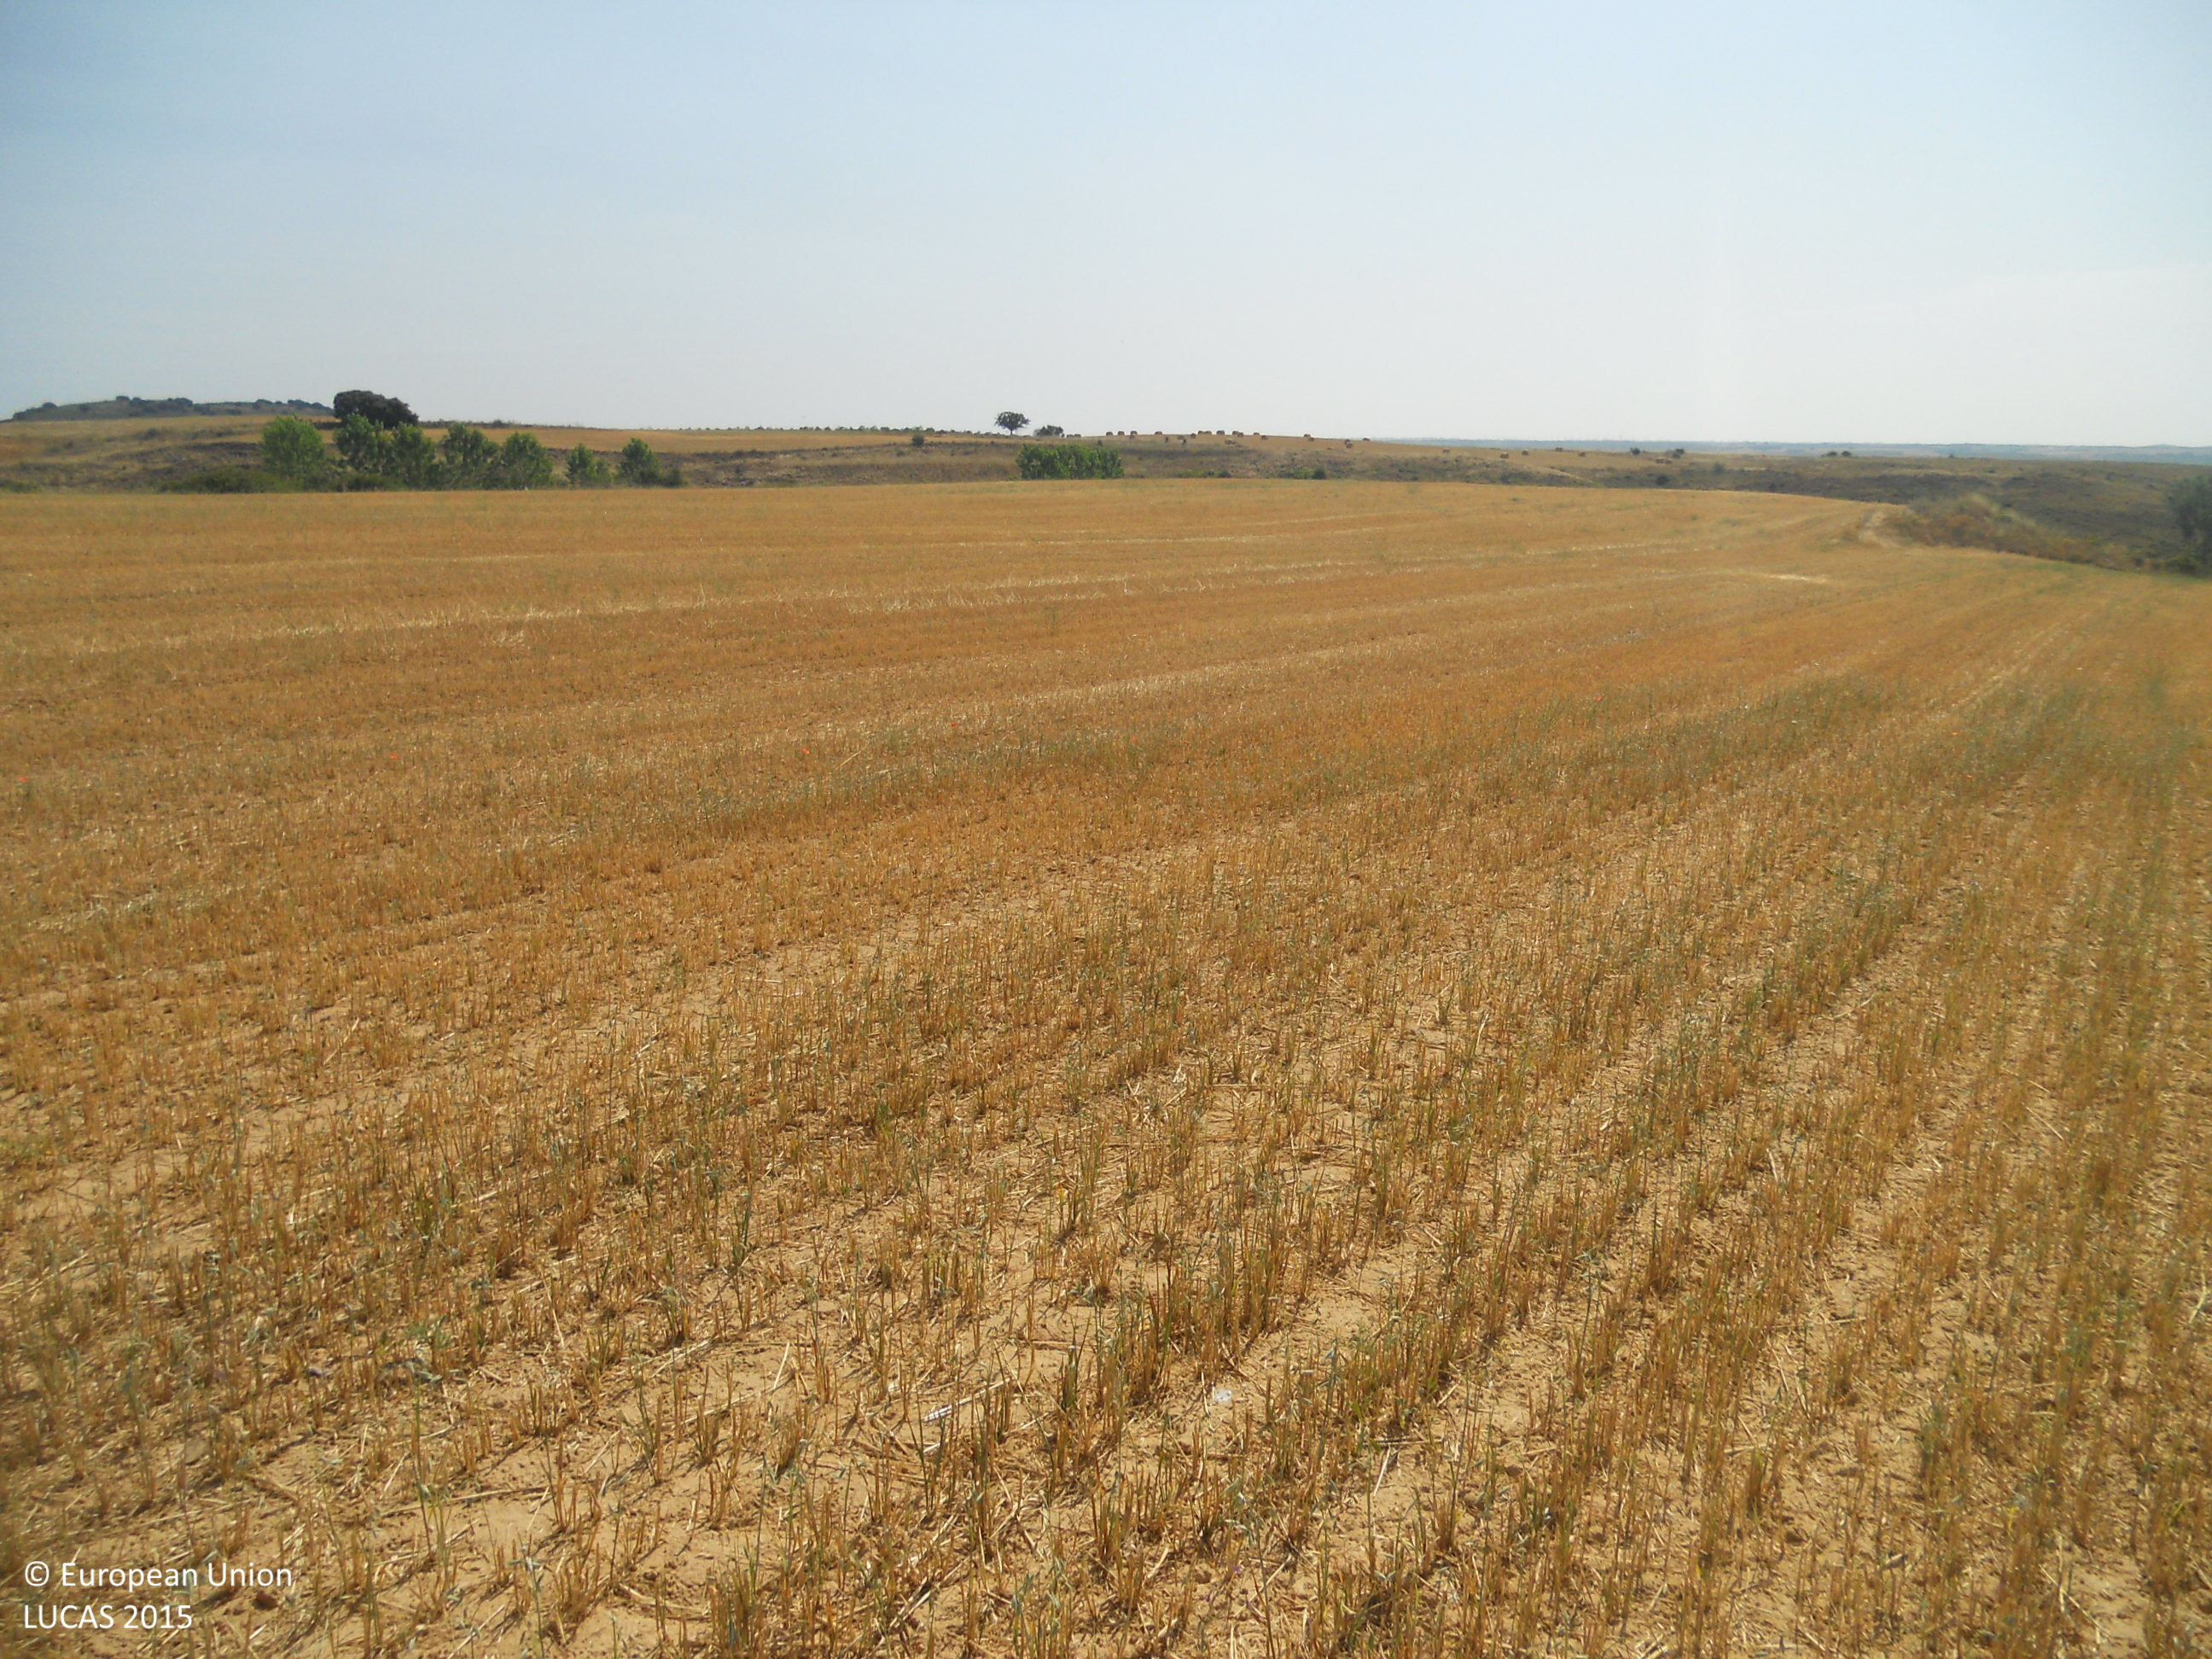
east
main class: Cropland
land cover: Oats
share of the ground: < 10 %
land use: Agriculture (excluding fallow land and kitchen gardens)
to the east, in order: Oats; Grassland with sparse tree/shrub cover; Tracks; Broadleaved woodland; Grassland without tree/shrub cover; Rivers and streams; Grassland with sparse tree/shrub cover
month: July
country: ES
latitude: 42.5616
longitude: -5.3295
